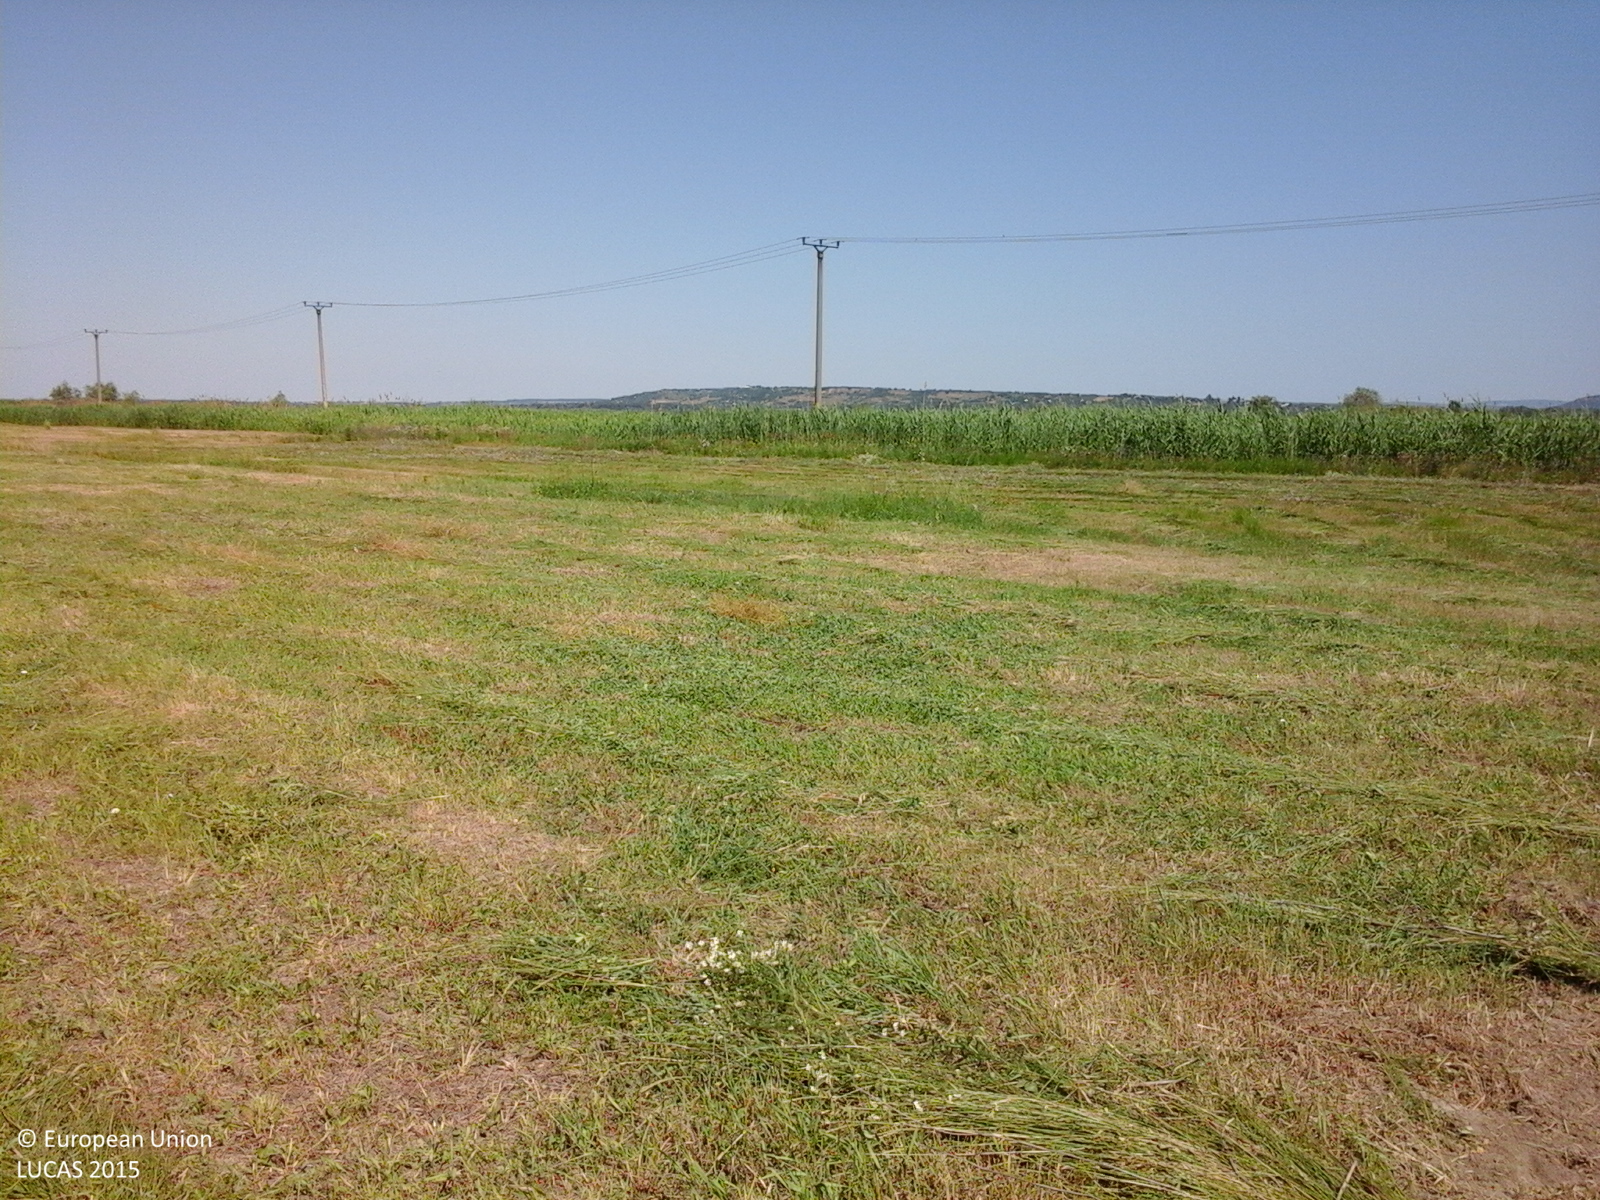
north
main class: Grassland
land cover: Grassland without tree/shrub cover
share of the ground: > 75 %
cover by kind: herbaceous plants 100 %
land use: Agriculture (excluding fallow land and kitchen gardens)
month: June
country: RO
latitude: 47.0012
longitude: 28.0034
